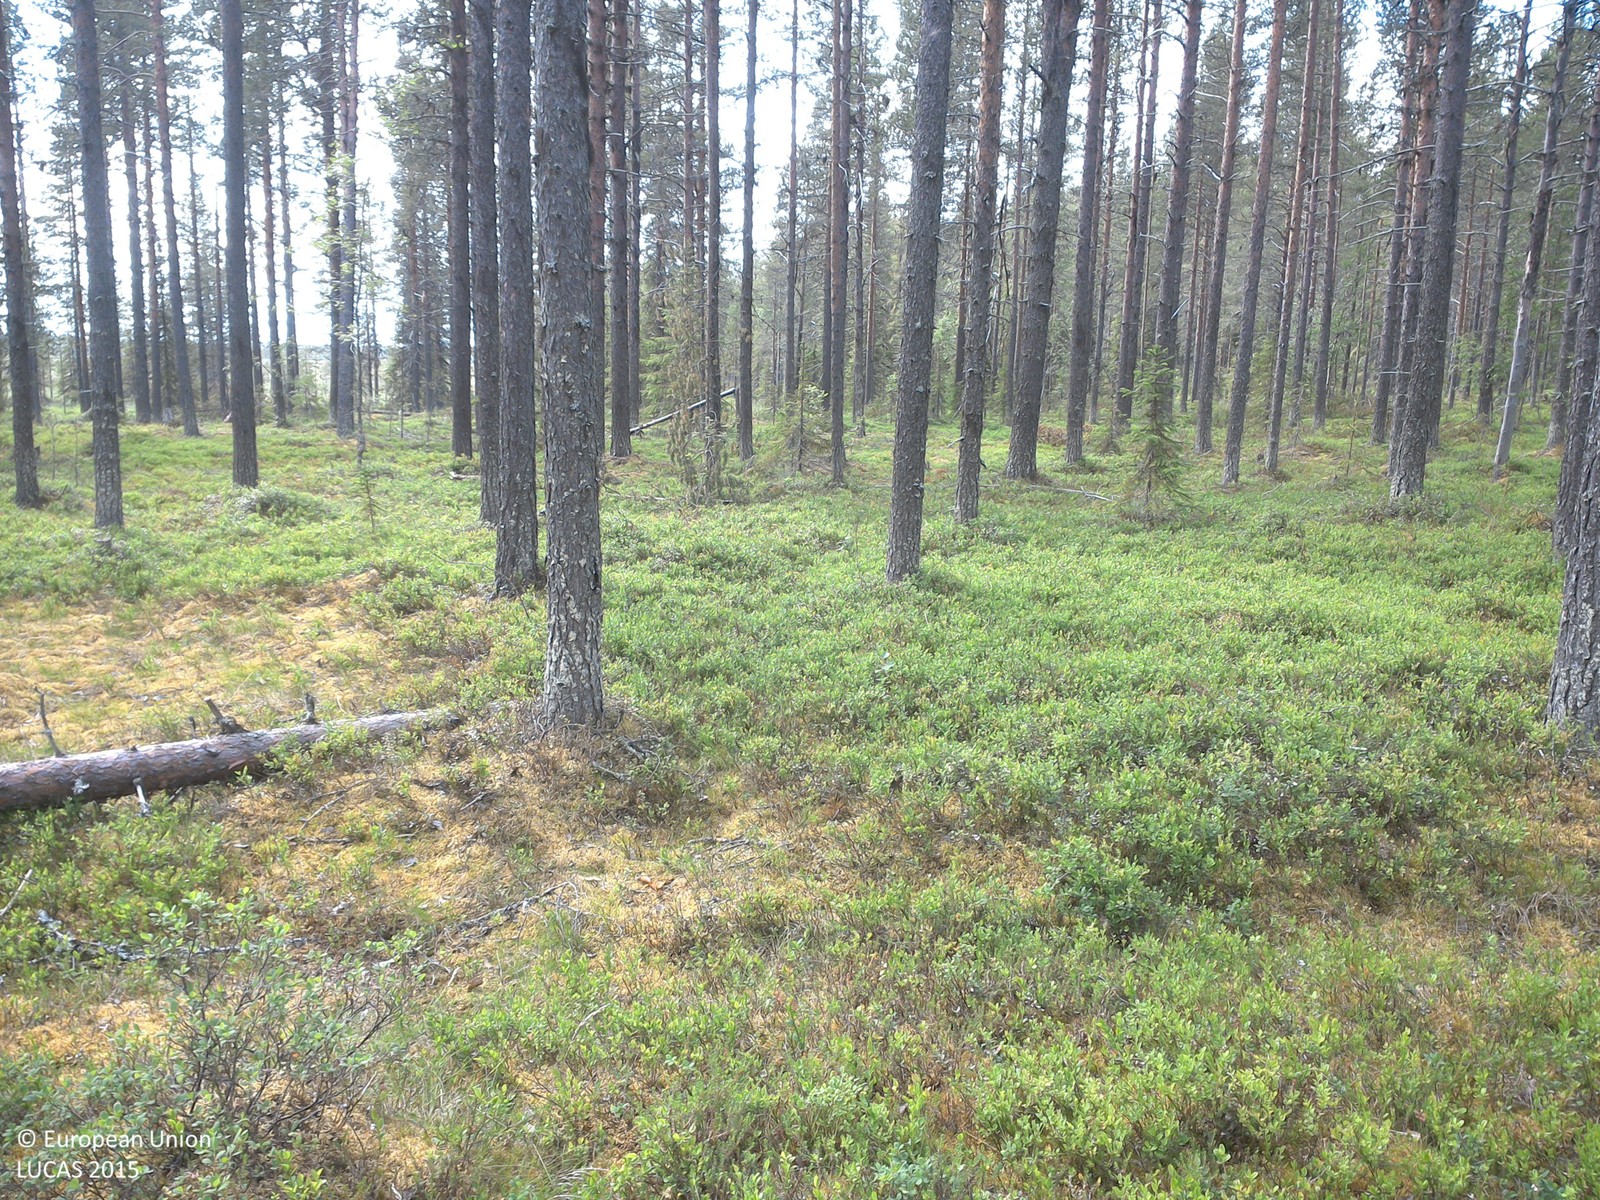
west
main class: Woodland
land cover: Pine dominated coniferous woodland
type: boreal forest
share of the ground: 25 - 50 %
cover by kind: shrubs 50 %, coniferous forest trees 35 %, lichens and mosses 15 %
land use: Forestry
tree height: > 5 m
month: July
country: SE
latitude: 67.6458
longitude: 22.7995
